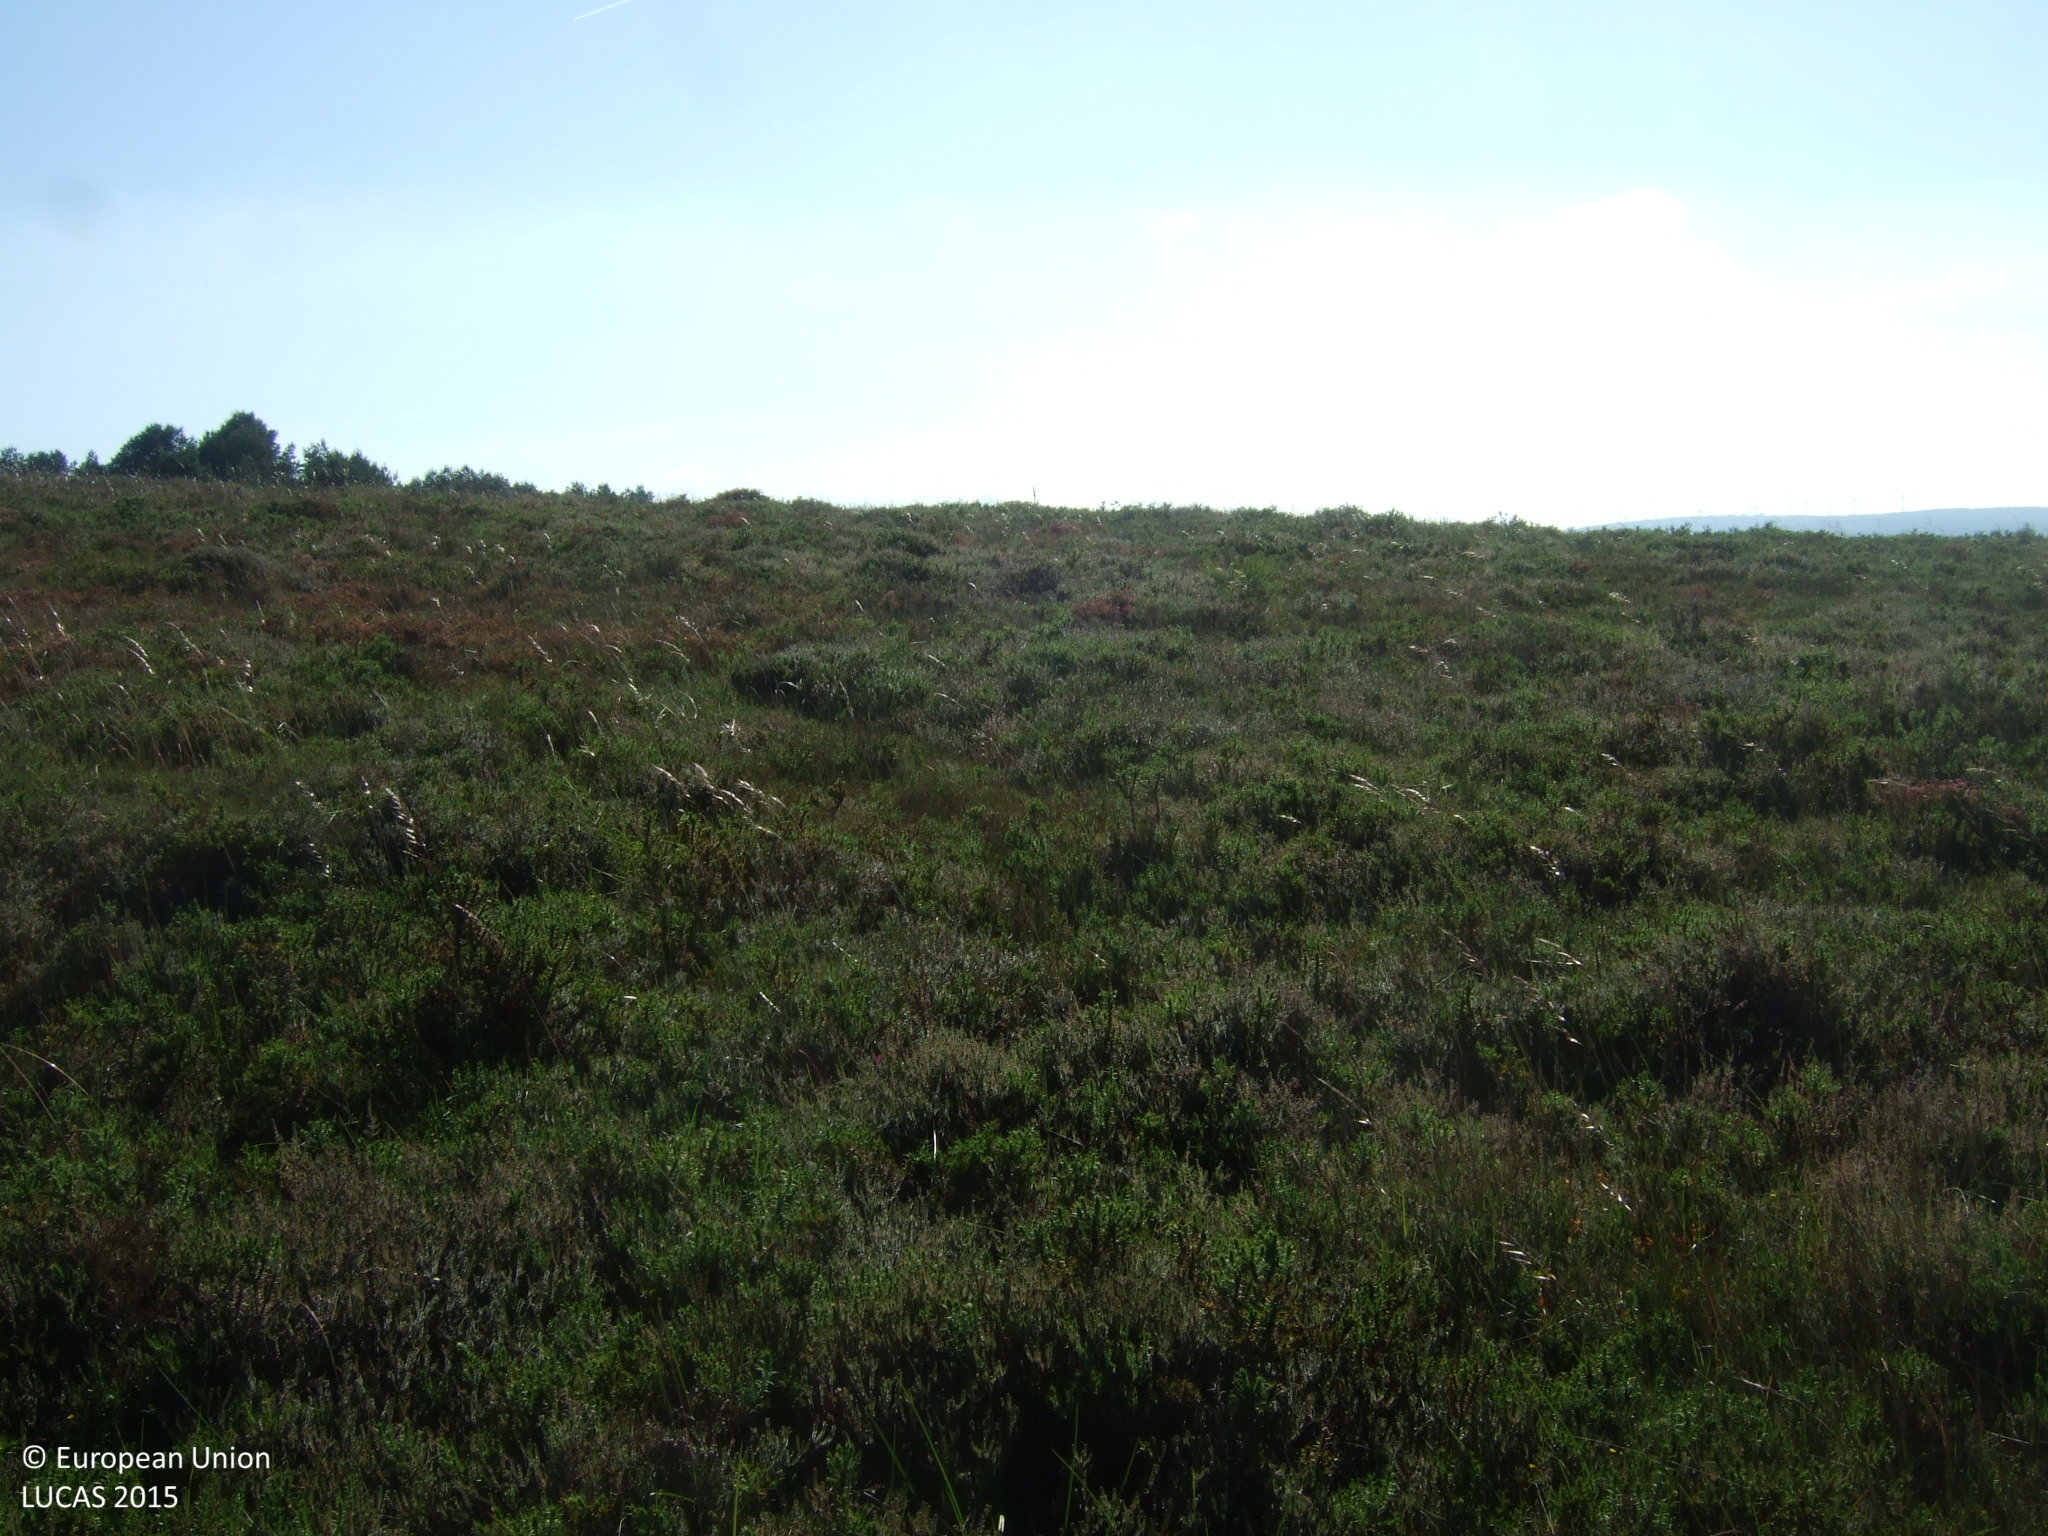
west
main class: Shrubland
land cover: Shrubland without tree cover
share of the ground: > 75 %
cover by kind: shrubs 100 %
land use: Semi-natural and natural areas not in use
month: June
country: ES
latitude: 43.4510
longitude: -7.7469
